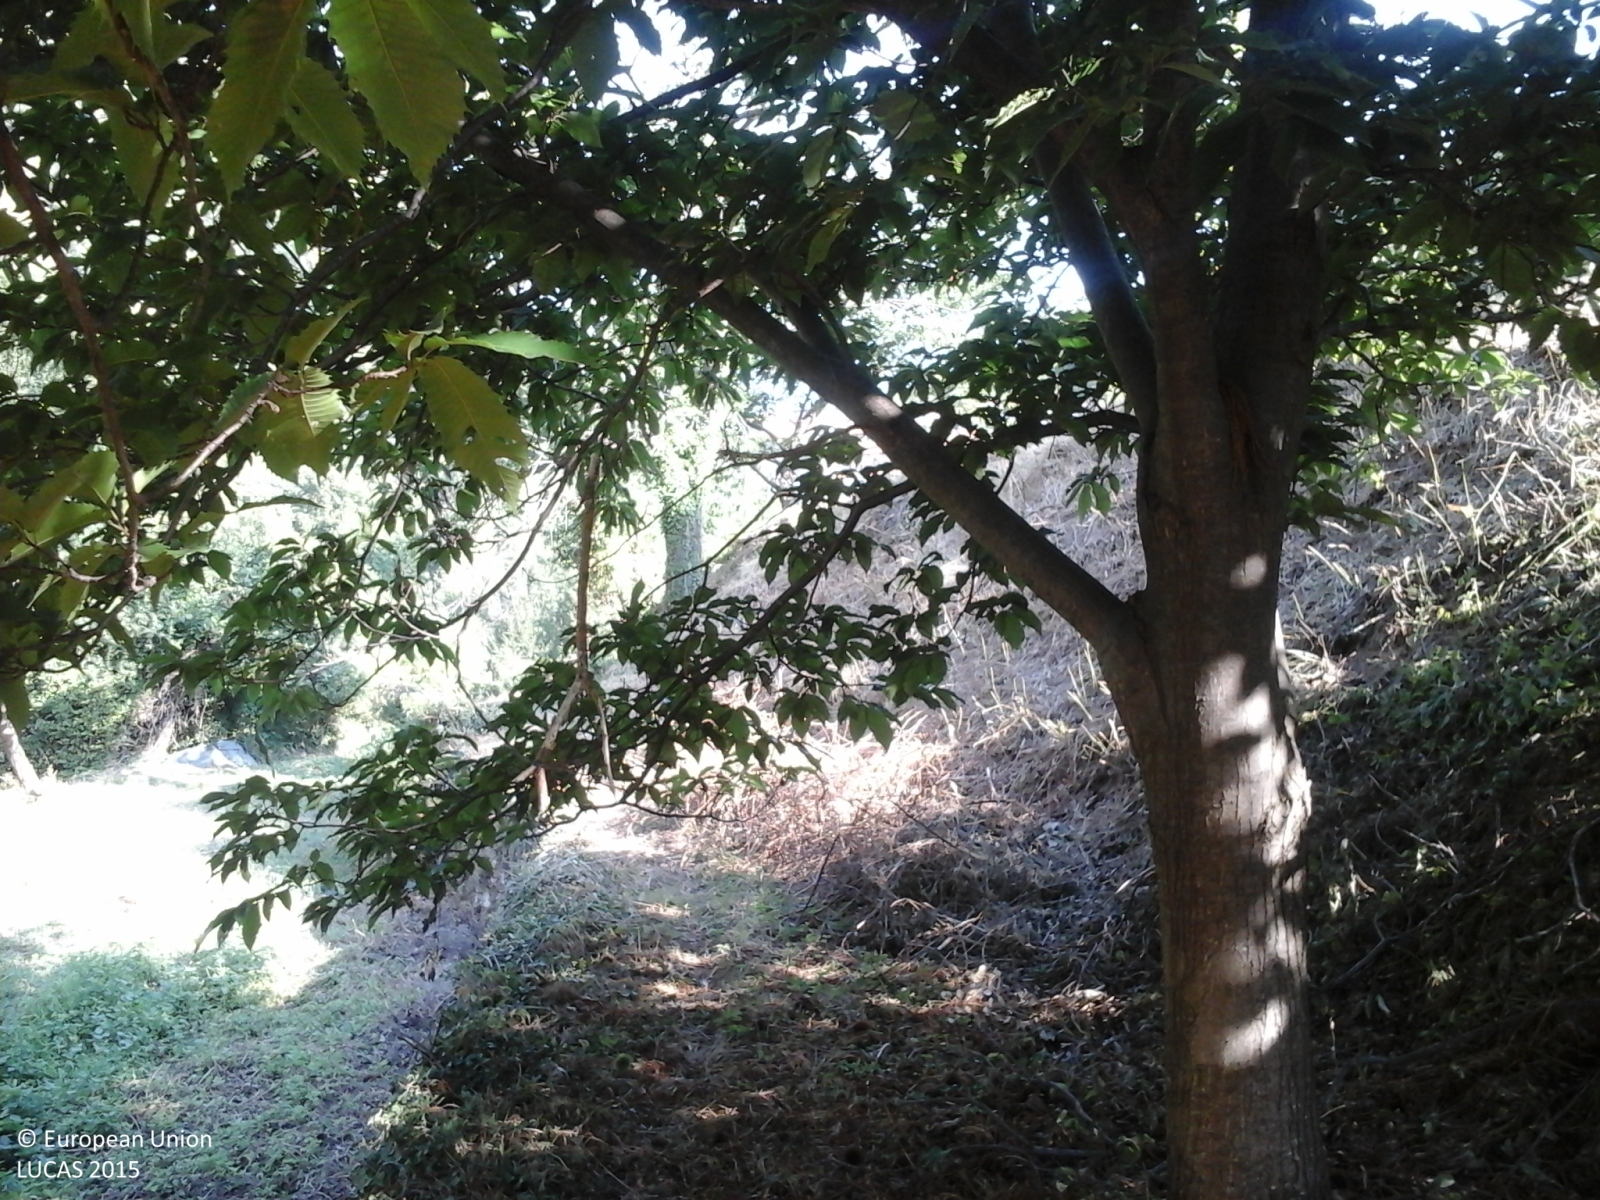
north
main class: Cropland
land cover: Nuts trees
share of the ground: 25 - 50 %
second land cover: Grassland without tree/shrub cover
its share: > 75 %
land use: Agriculture (excluding fallow land and kitchen gardens)
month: August
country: IT
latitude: 44.1521
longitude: 8.0665
